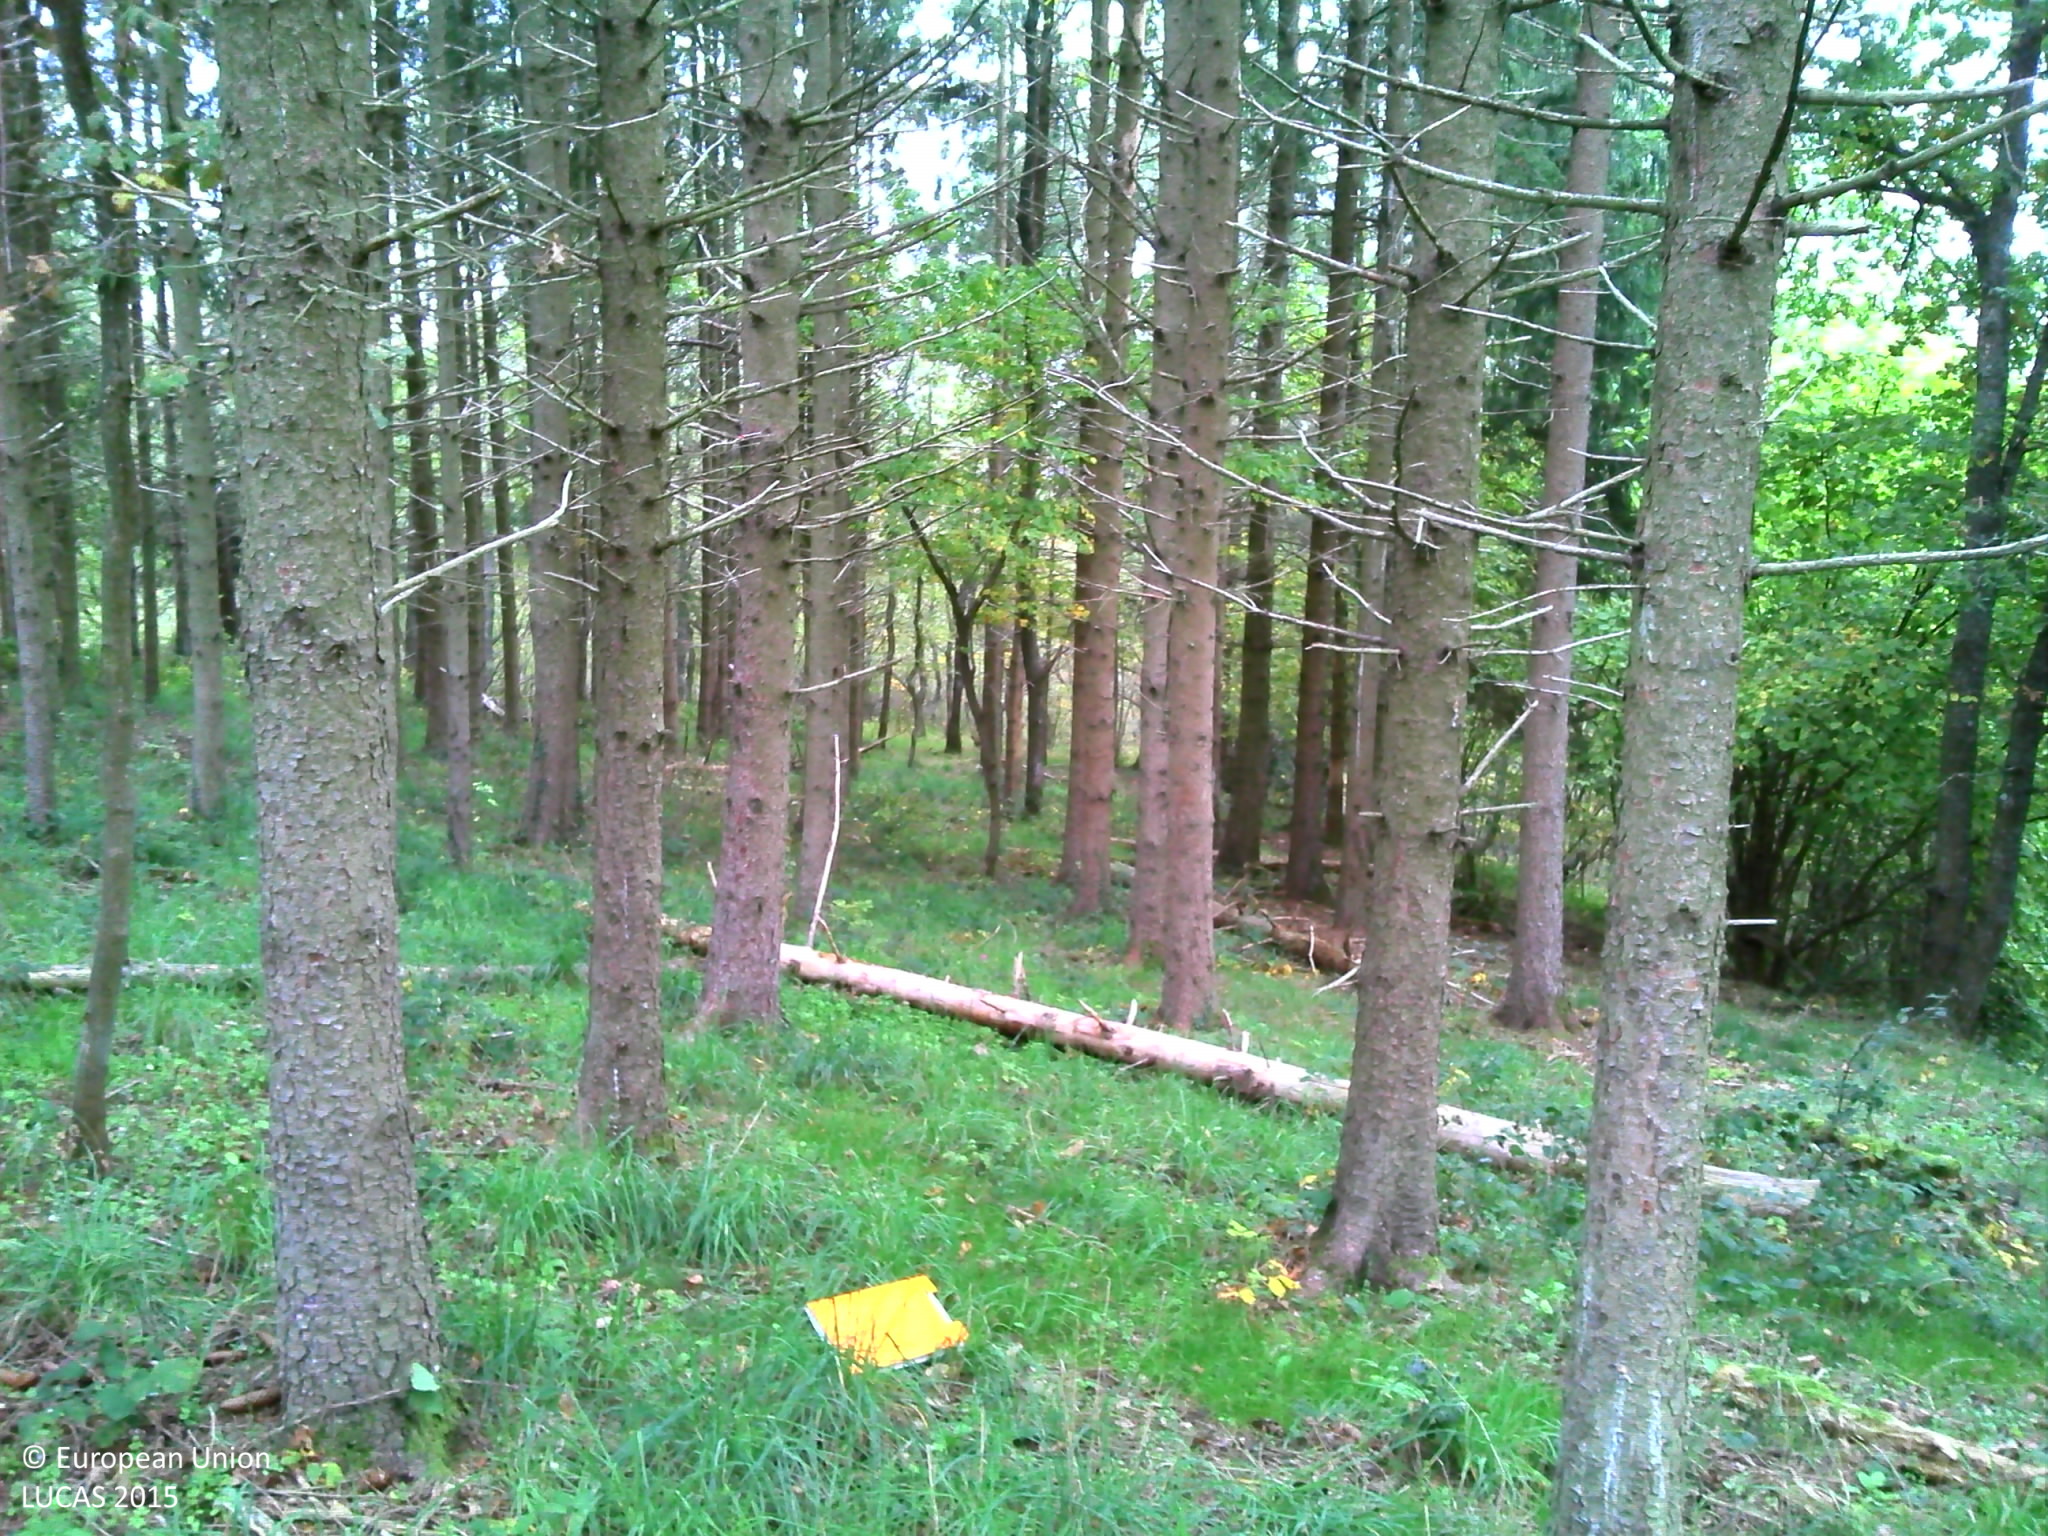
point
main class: Woodland
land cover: Spruce dominated coniferous woodland
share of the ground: > 75 %
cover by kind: coniferous forest trees 85 %, herbaceous plants 10 %, broadleaved forest trees 5 %
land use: Forestry
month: October
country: FR
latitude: 46.0140
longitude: 3.0113
